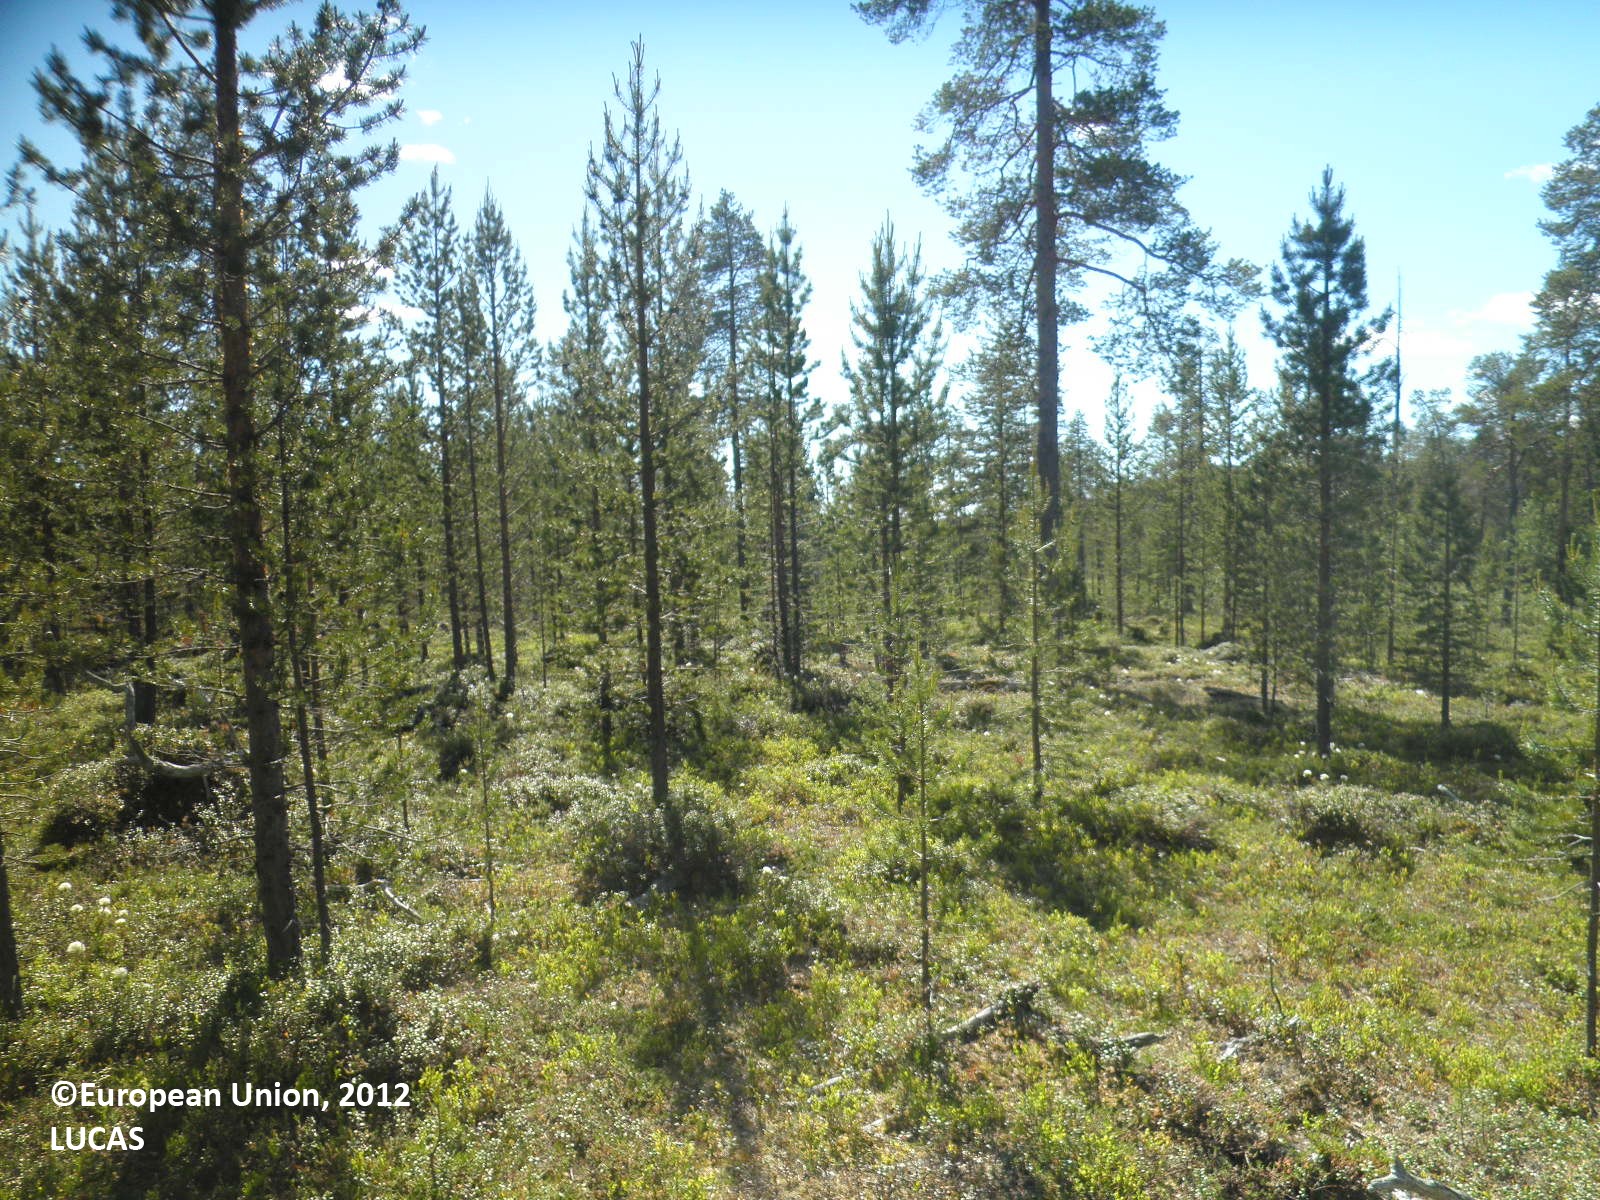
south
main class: Woodland
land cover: Pine dominated coniferous woodland
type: boreal forest
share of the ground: 25 - 50 %
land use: Forestry
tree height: > 5 m
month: July
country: FI
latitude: 68.7972
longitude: 26.8302
